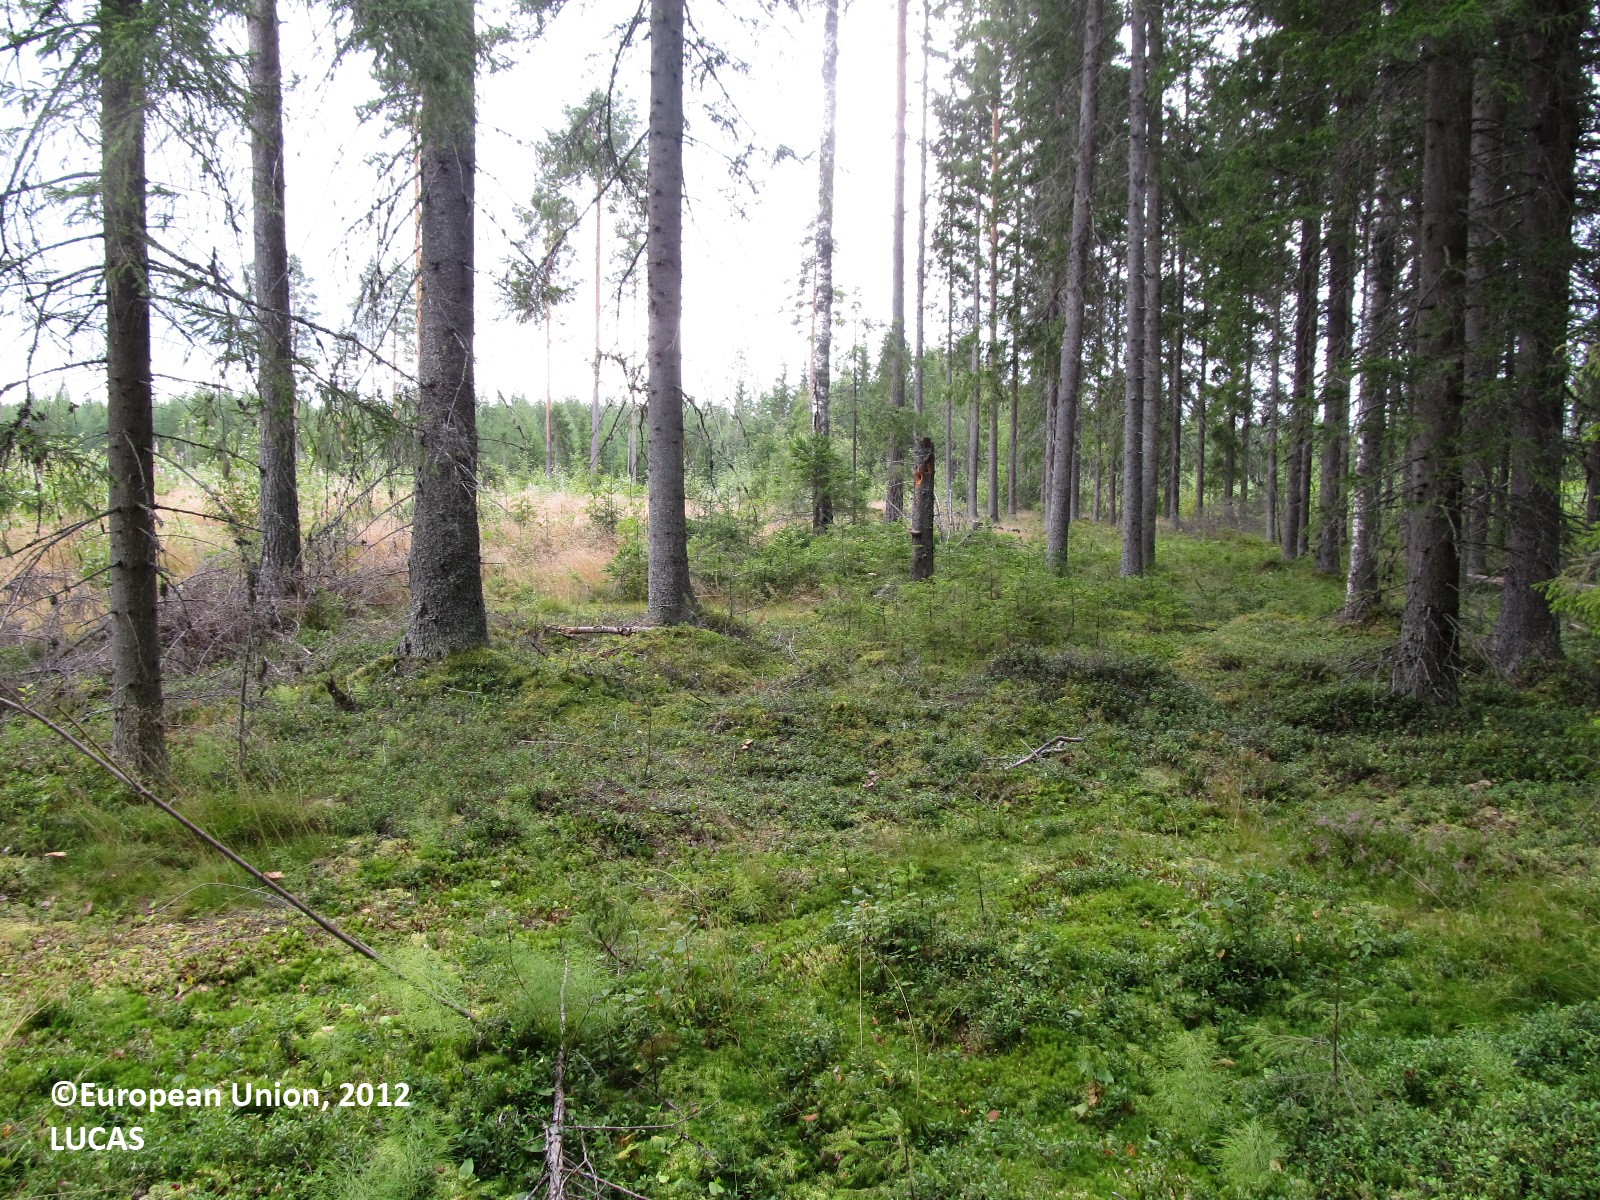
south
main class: Woodland
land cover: Pine dominated mixed woodland
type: boreal forest
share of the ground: 25 - 50 %
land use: Forestry
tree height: > 5 m
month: August
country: FI
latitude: 62.0542
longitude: 27.5216
